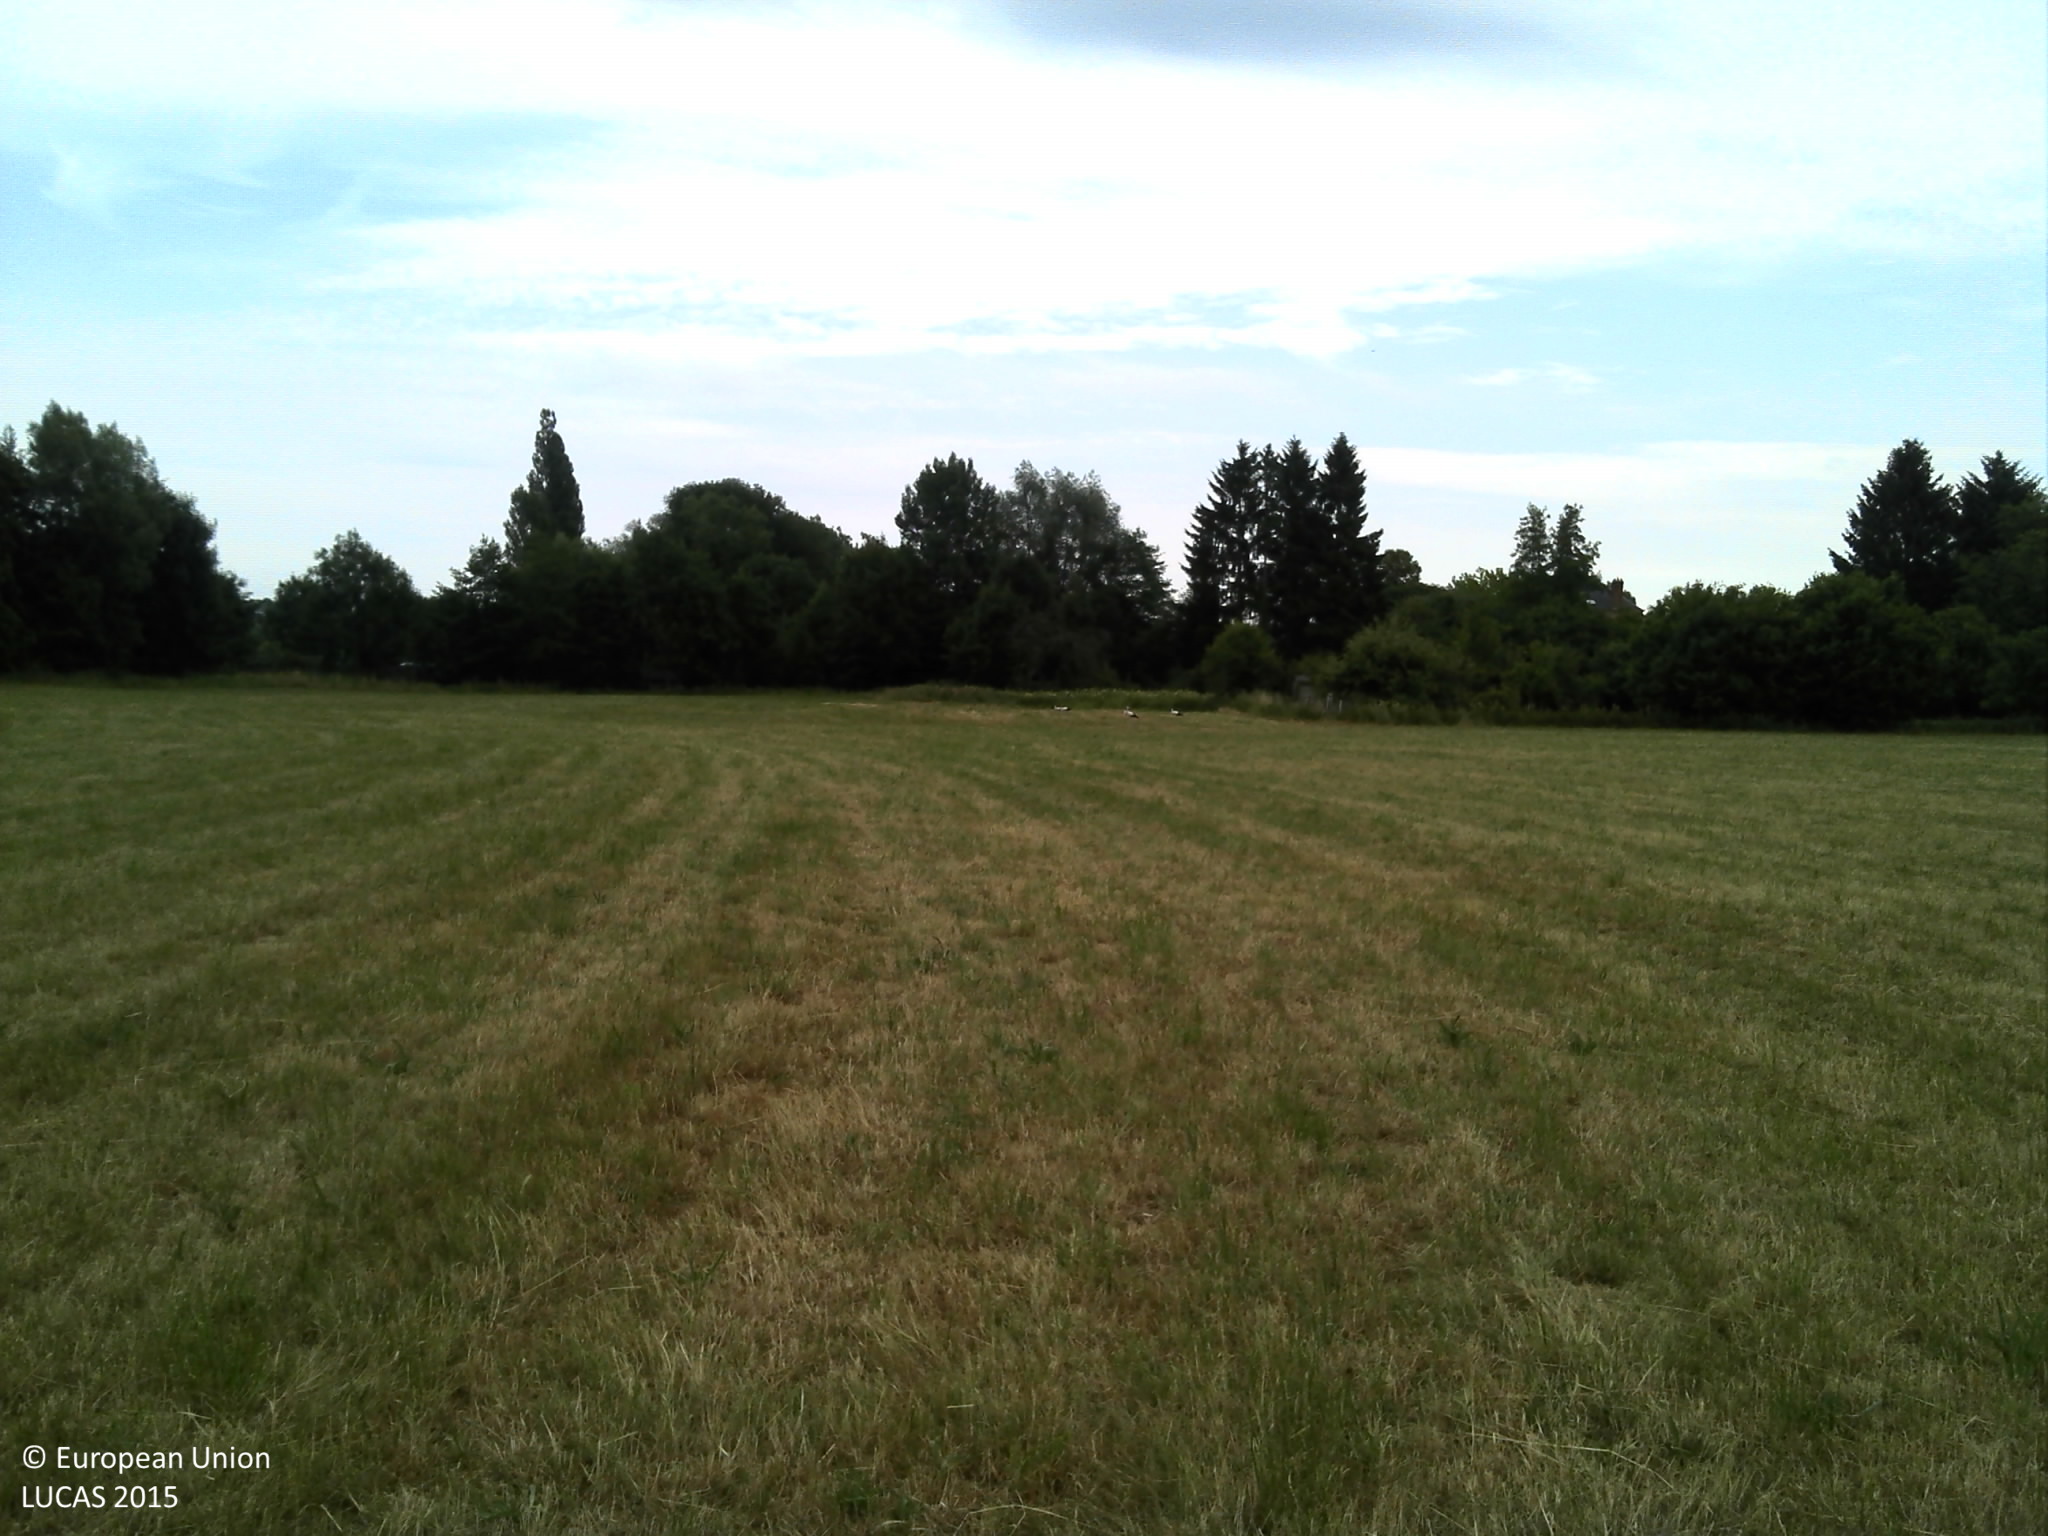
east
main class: Grassland
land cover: Grassland without tree/shrub cover
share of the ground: > 75 %
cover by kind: herbaceous plants 100 %
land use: Agriculture (excluding fallow land and kitchen gardens)
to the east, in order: Grassland without tree/shrub cover; Broadleaved woodland; Inland fresh running water; Paved roads, cycling and walking lanes; Broadleaved woodland; Fences; Grassland without tree/shrub cover
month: July
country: FR
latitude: 49.7717
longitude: 4.6785
